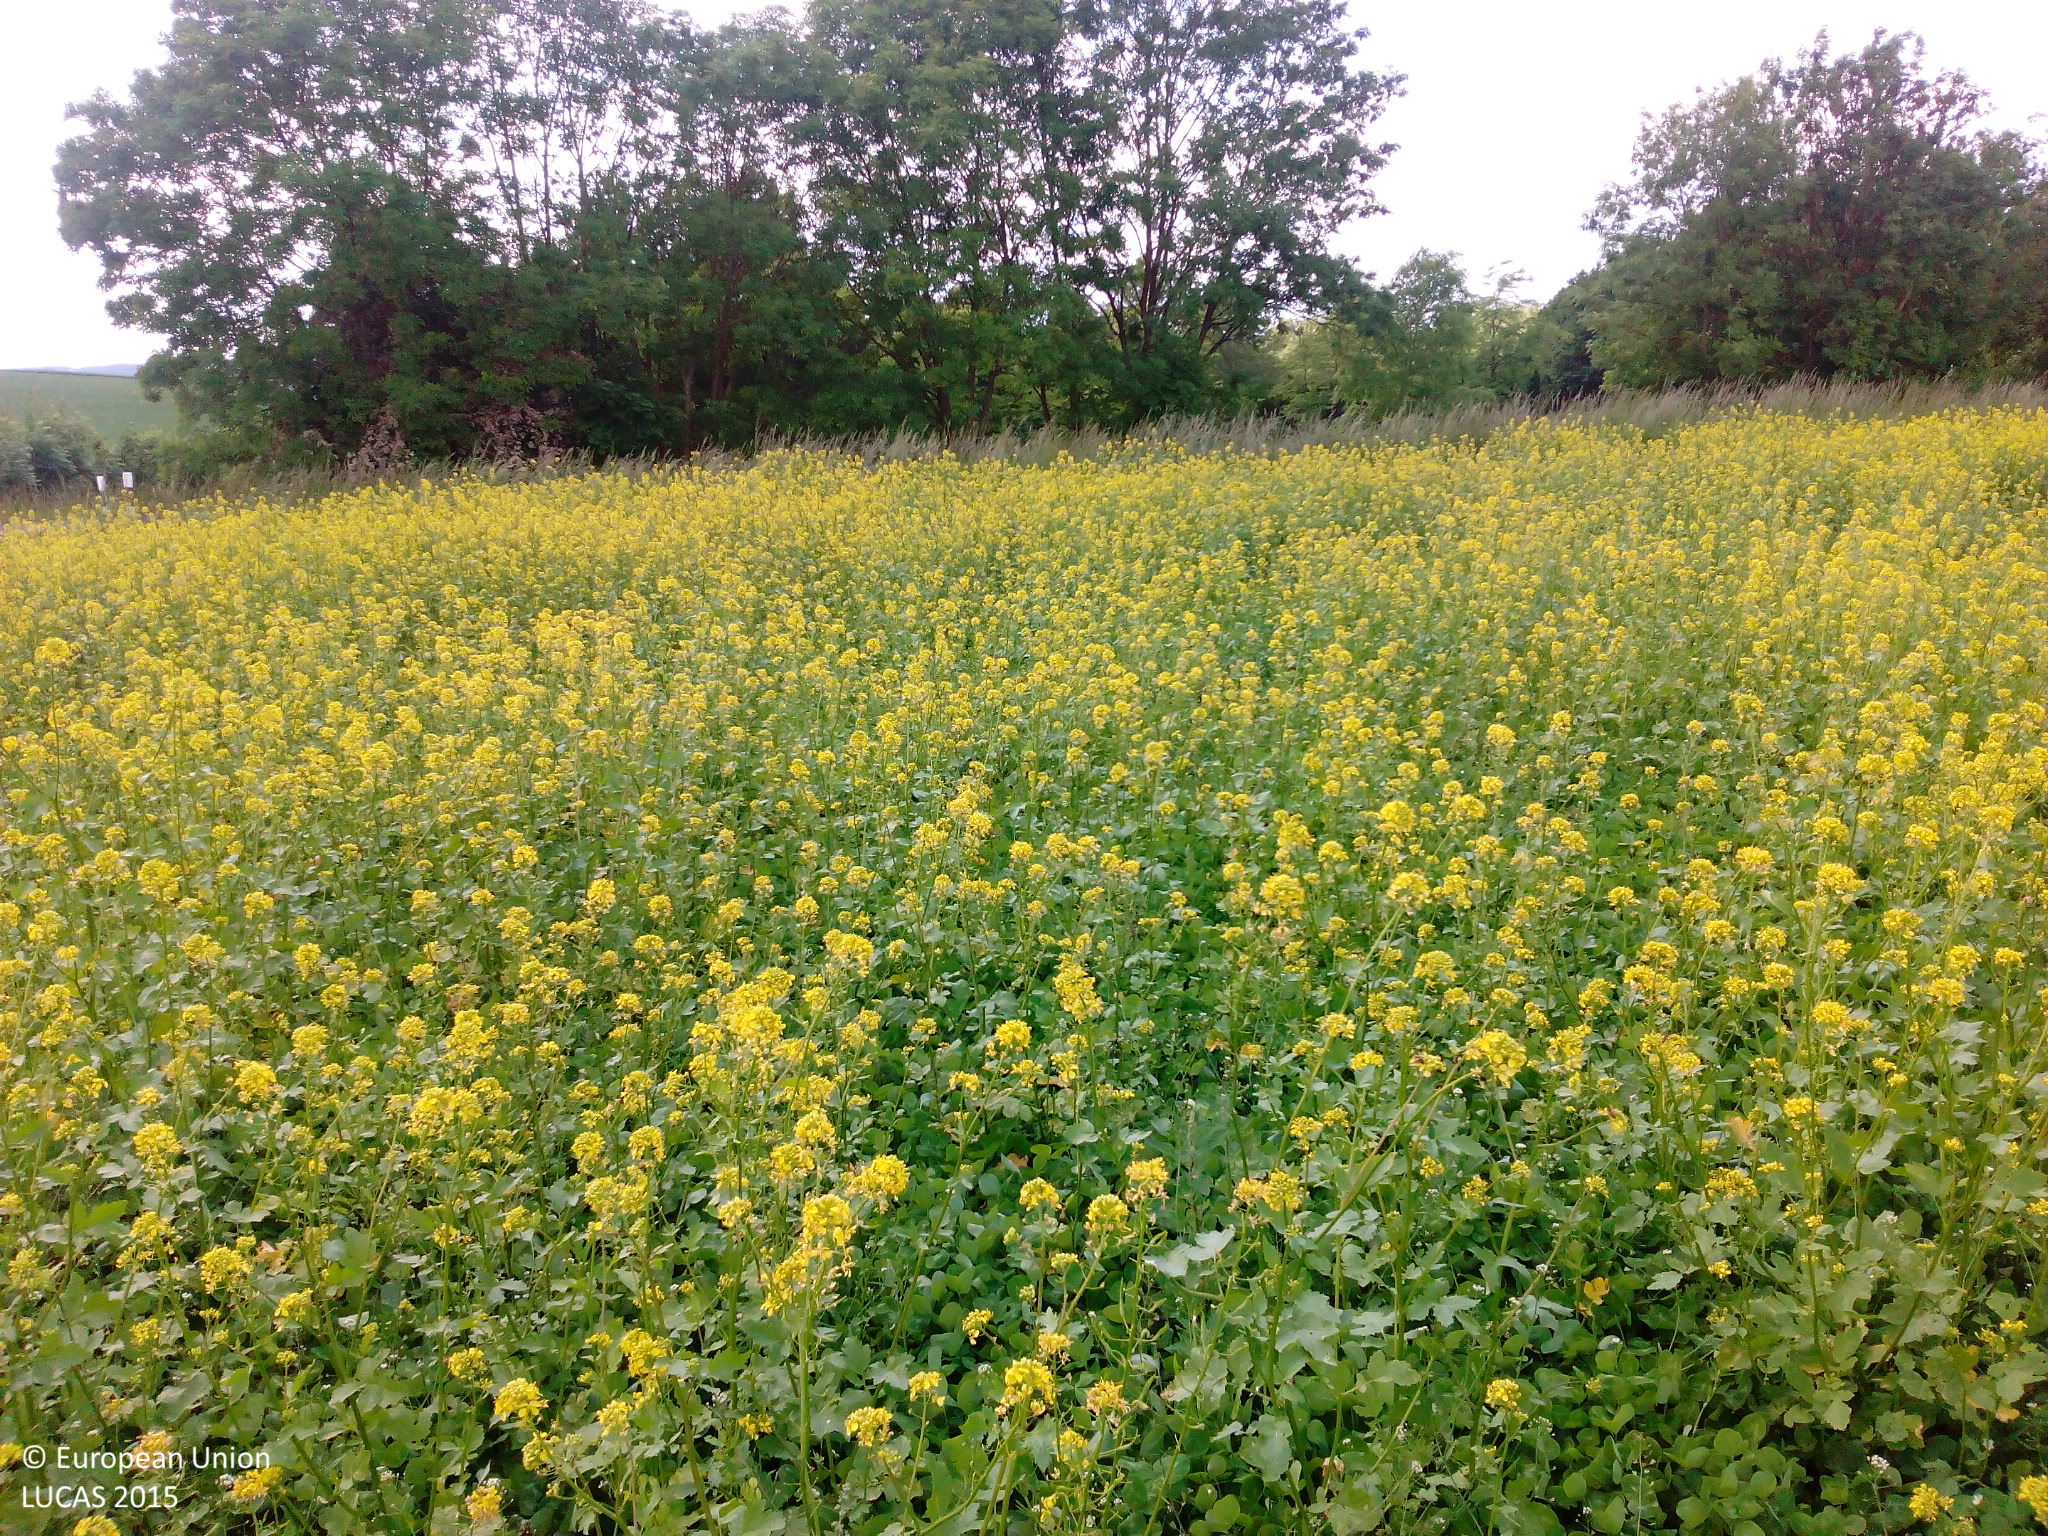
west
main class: Cropland
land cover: Rape and turnip rape
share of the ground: > 75 %
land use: Agriculture (excluding fallow land and kitchen gardens)
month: June
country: DE
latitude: 48.8547
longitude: 11.9210
